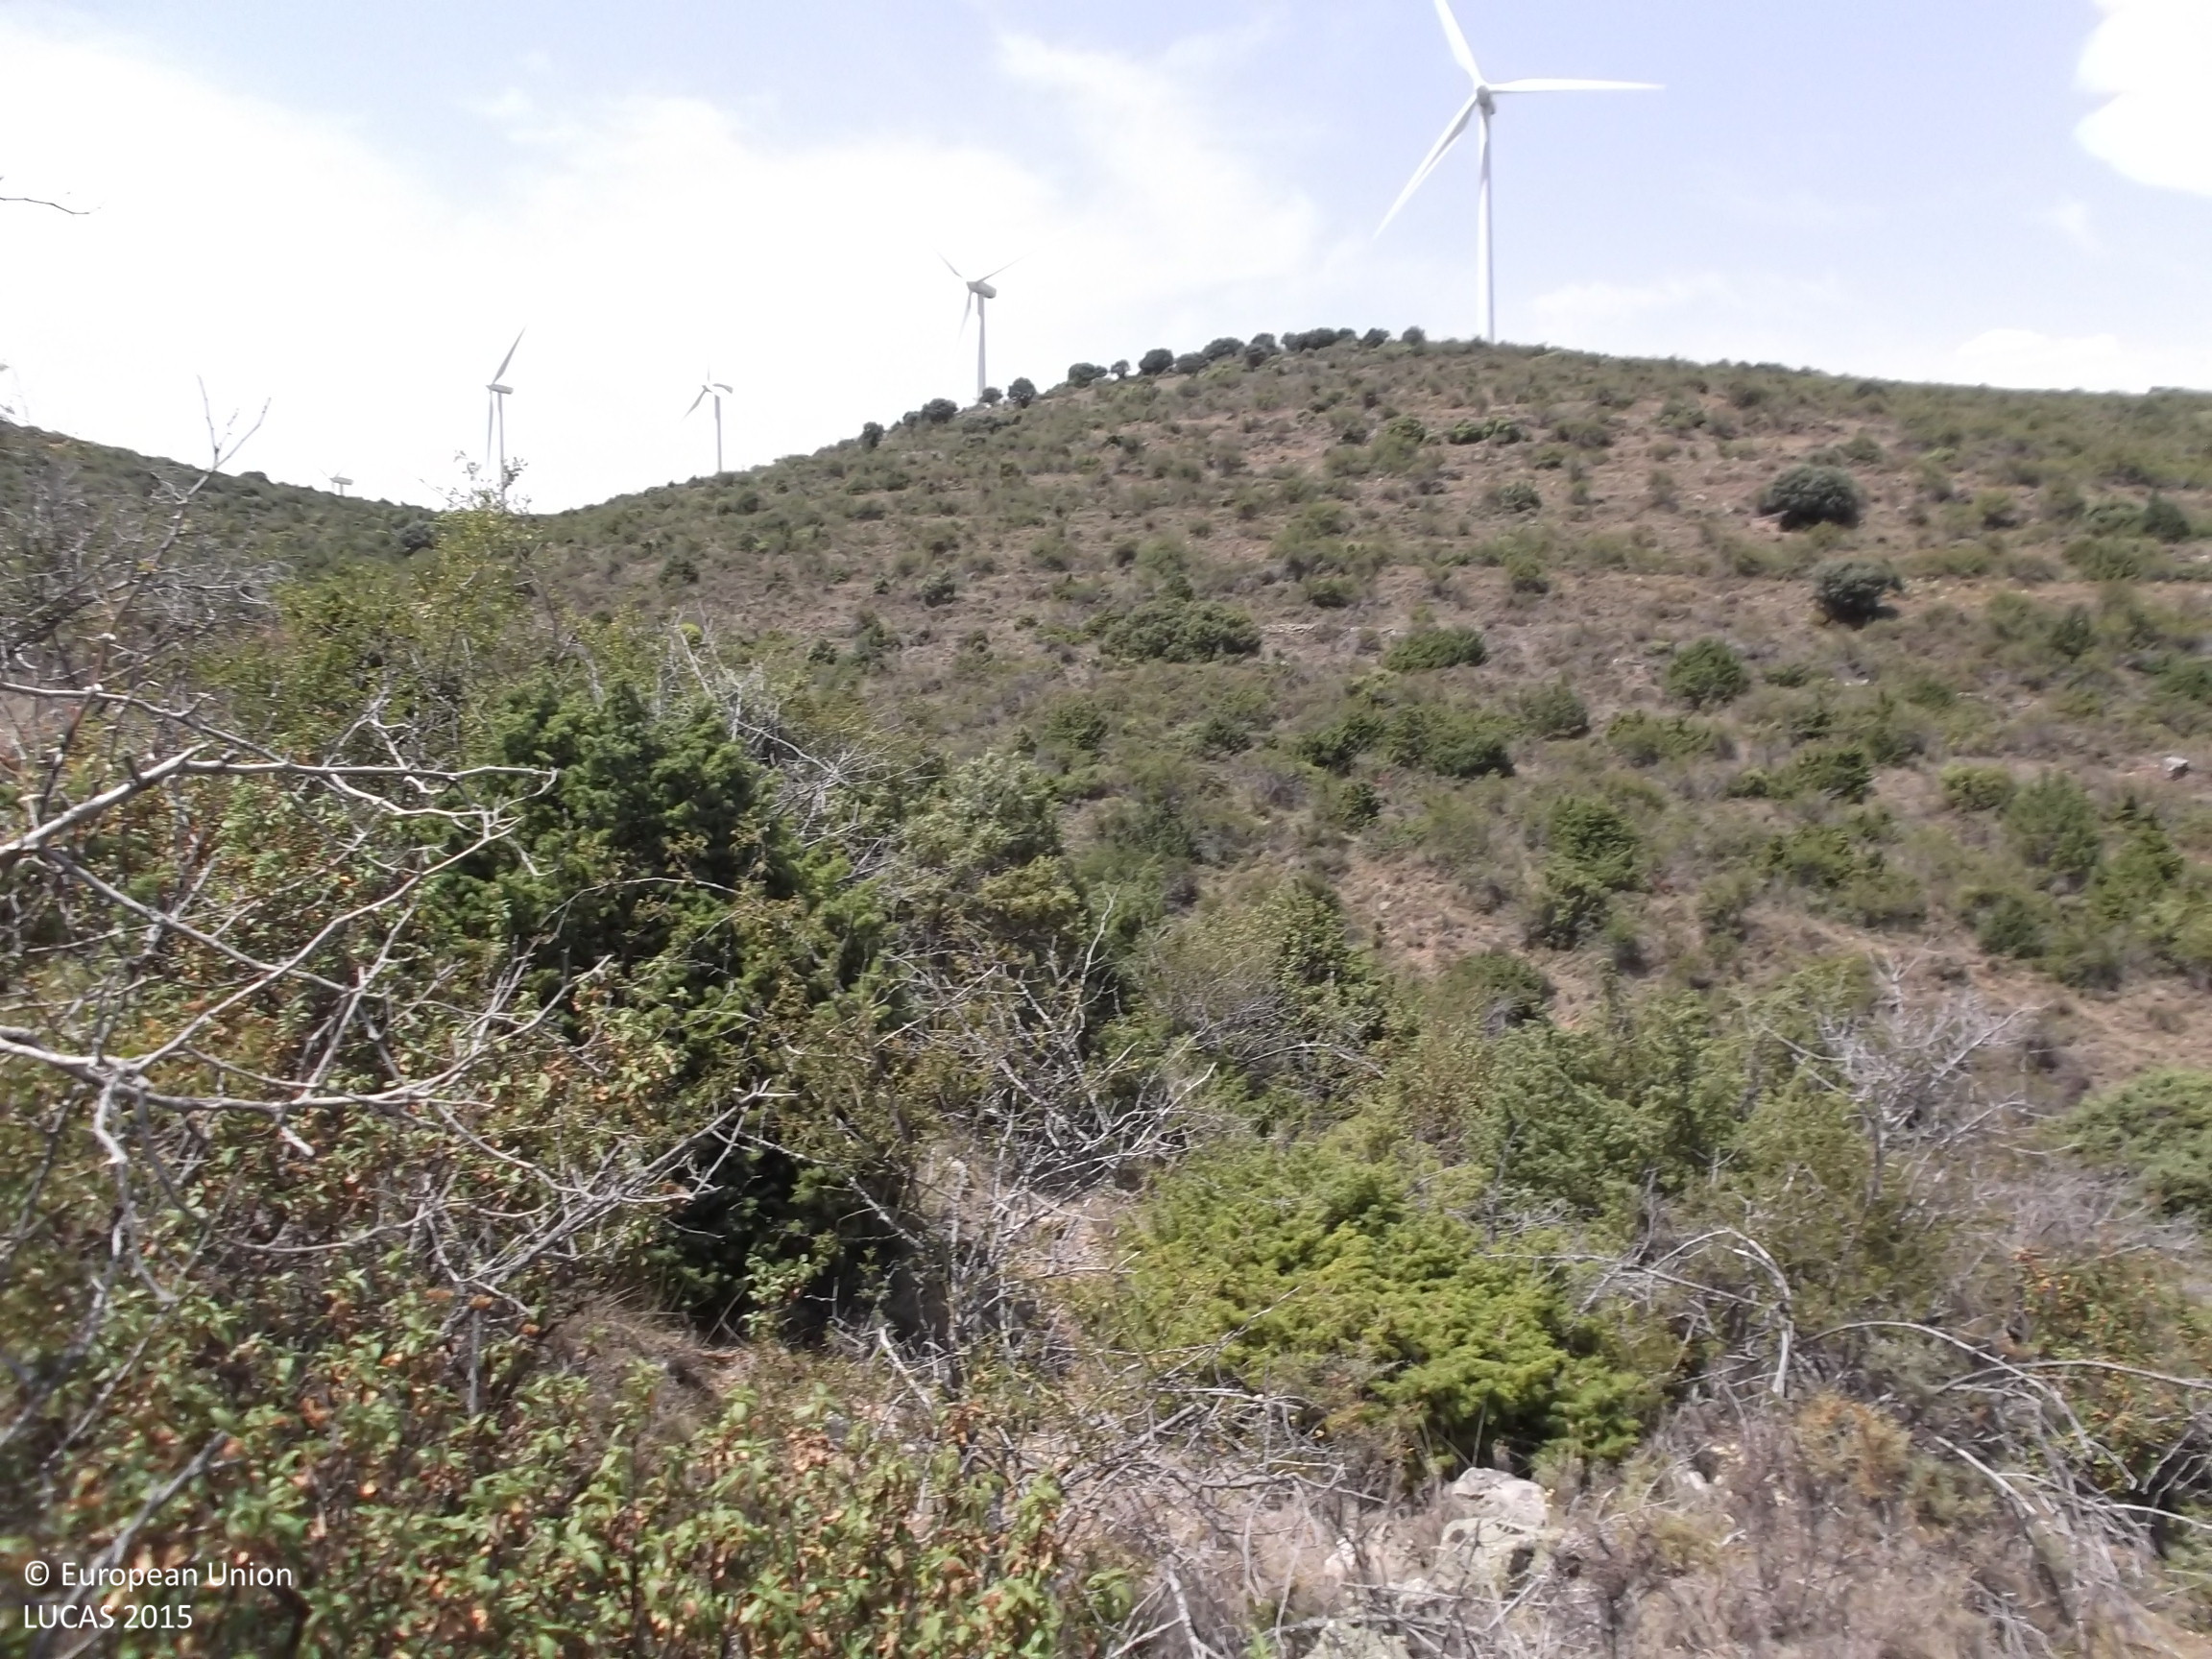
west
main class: Shrubland
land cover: Shrubland with sparse tree cover
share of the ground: > 75 %
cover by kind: shrubs 80 %, unconsolidated bare surface 15 %, broadleaved forest trees 5 %
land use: Agriculture (excluding fallow land and kitchen gardens)
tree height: < 5 m
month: July
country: ES
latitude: 42.0227
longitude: -2.0527
